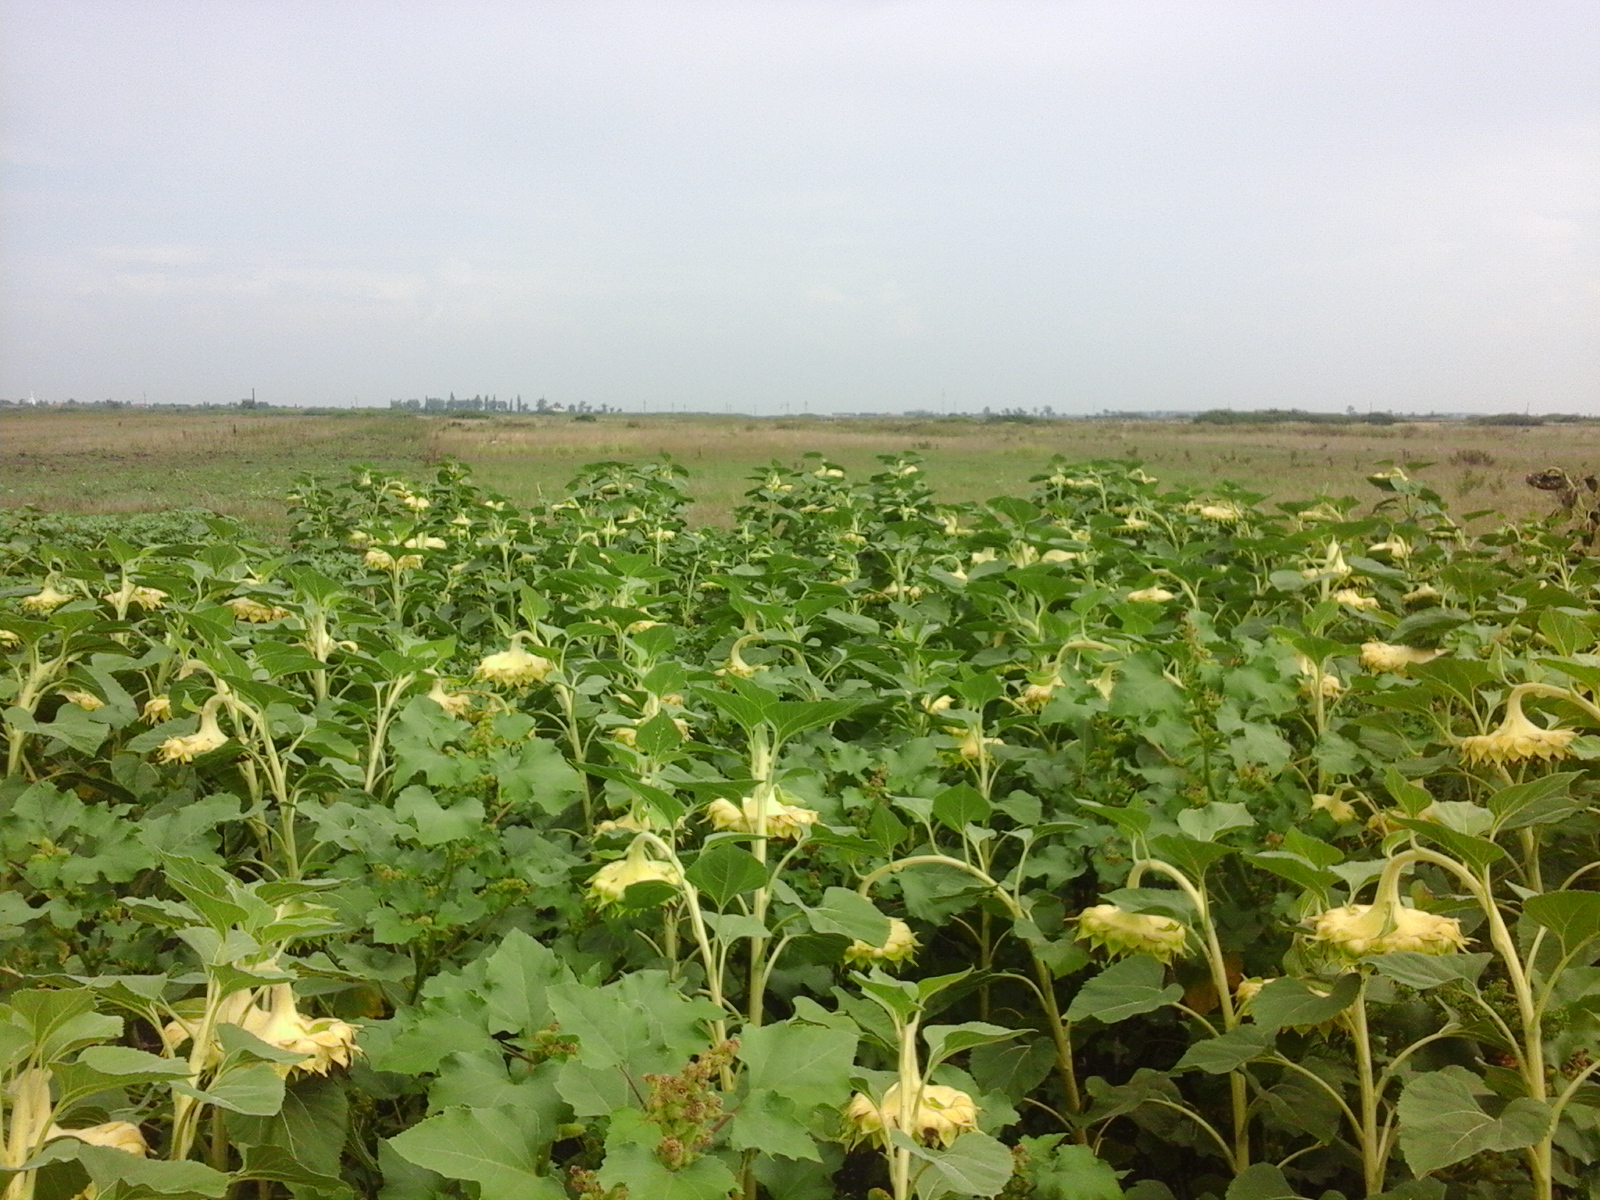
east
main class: Cropland
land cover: Sunflower
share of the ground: > 75 %
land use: Agriculture (excluding fallow land and kitchen gardens)
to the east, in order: Sunflower; Grass margins; Tracks; Spontaneously vegetated surfaces
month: August
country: RO
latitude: 46.6207
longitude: 21.4912
